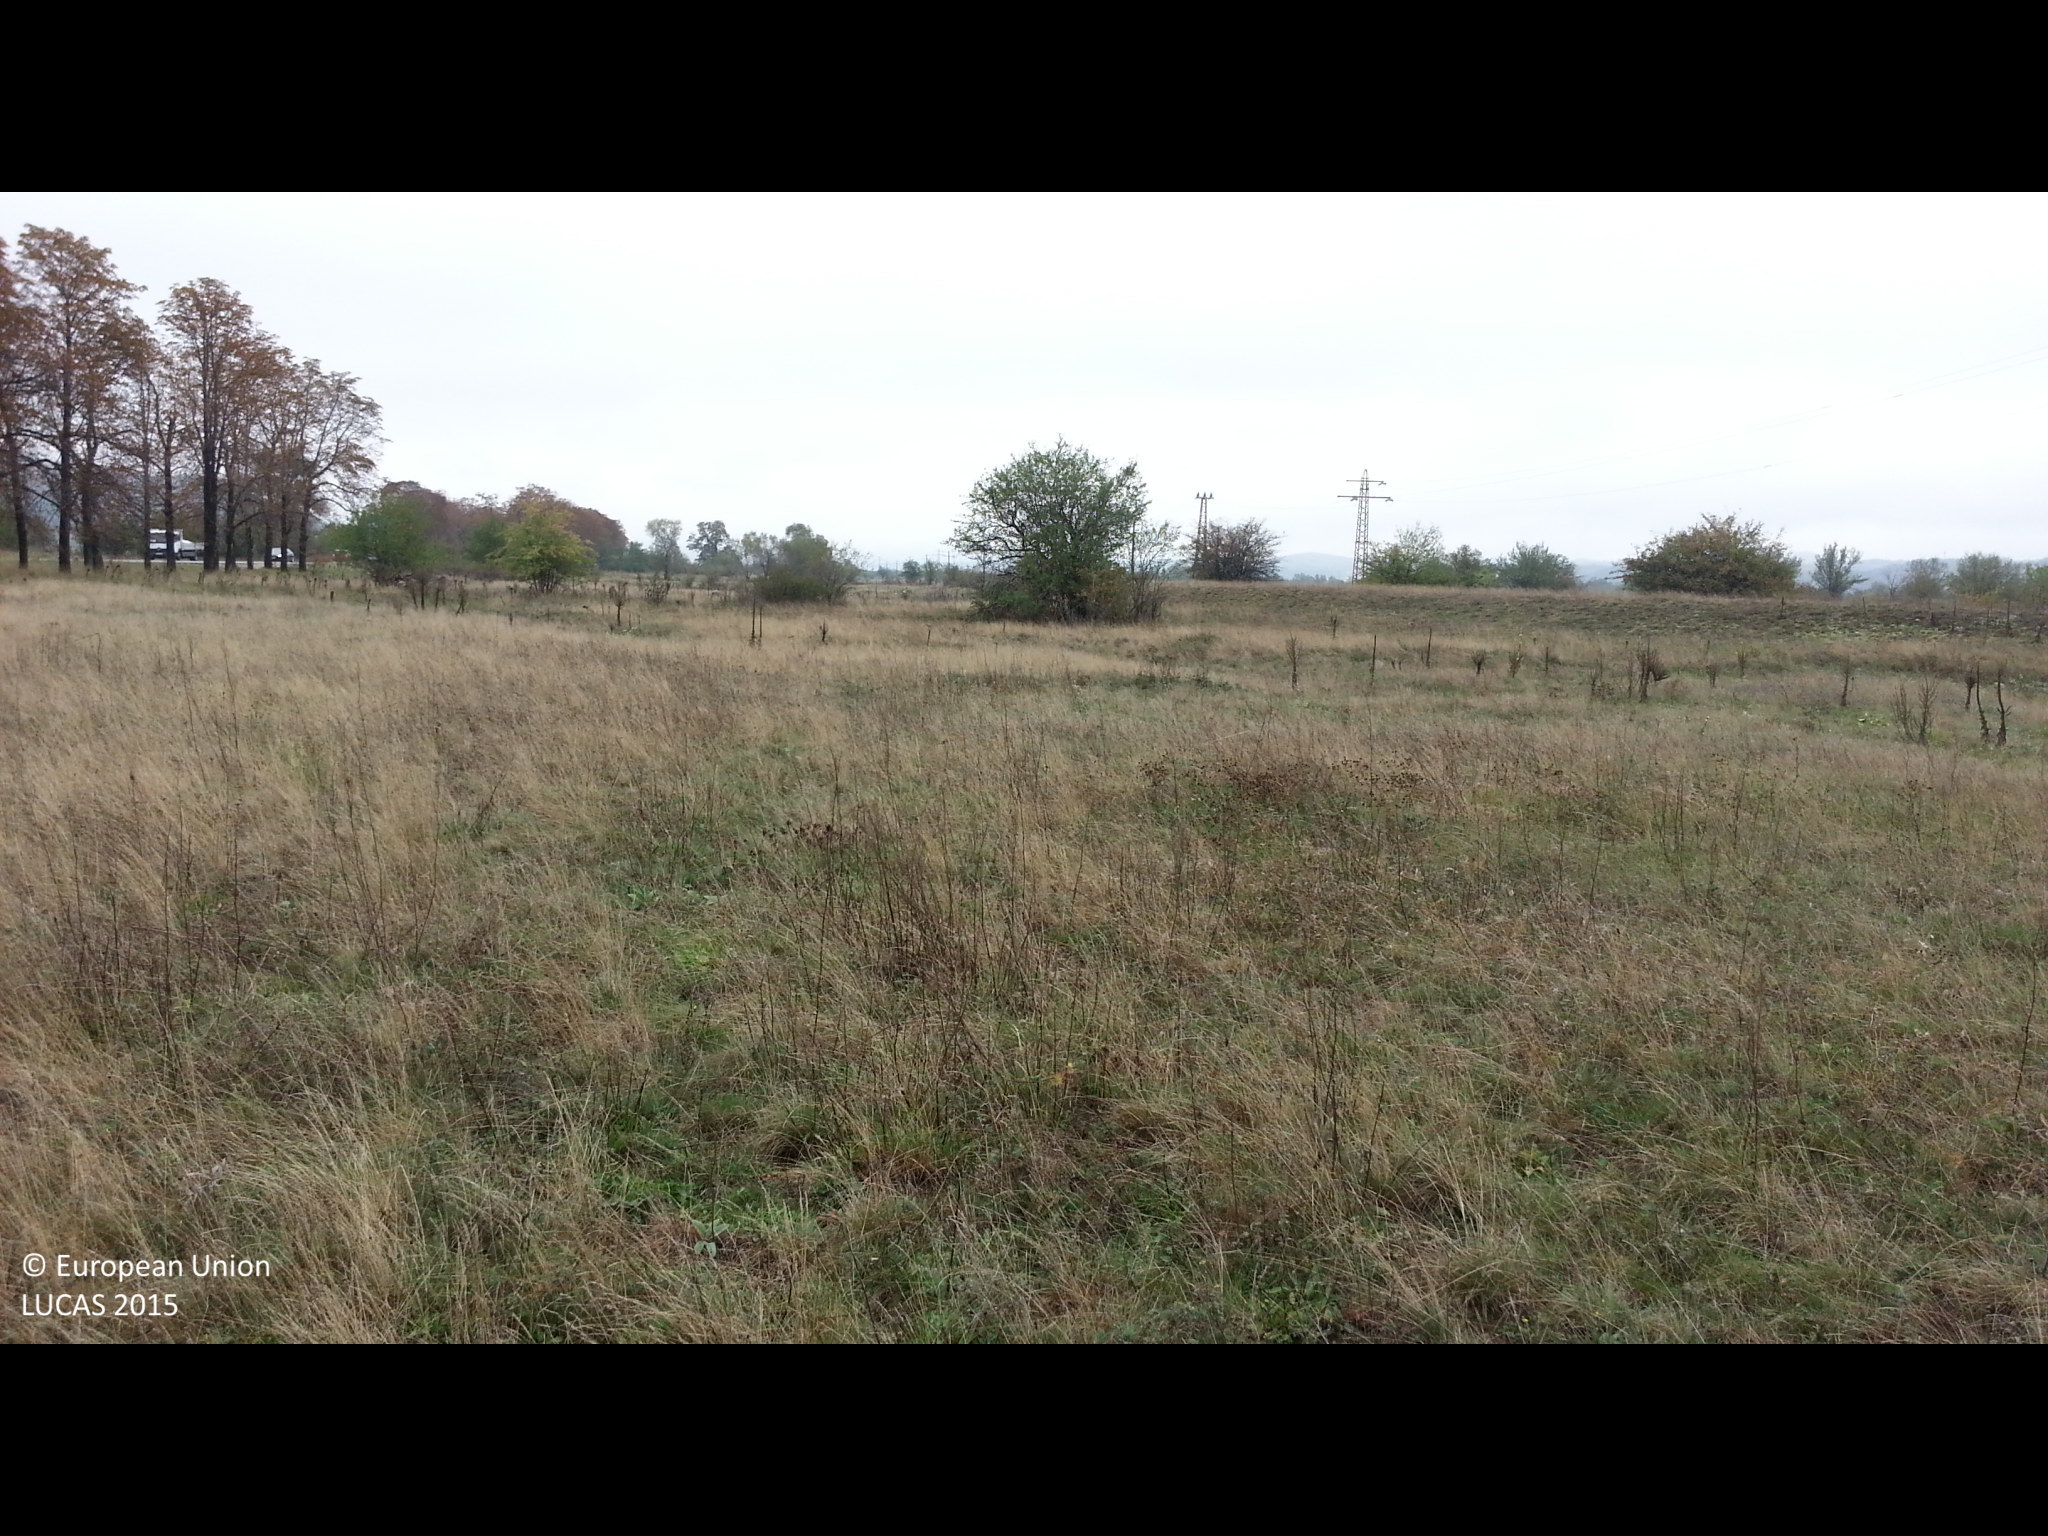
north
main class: Grassland
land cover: Grassland without tree/shrub cover
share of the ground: > 75 %
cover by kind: herbaceous plants 100 %
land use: Agriculture (excluding fallow land and kitchen gardens)
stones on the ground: < 10 %
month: October
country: BG
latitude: 42.3608
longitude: 23.5478
